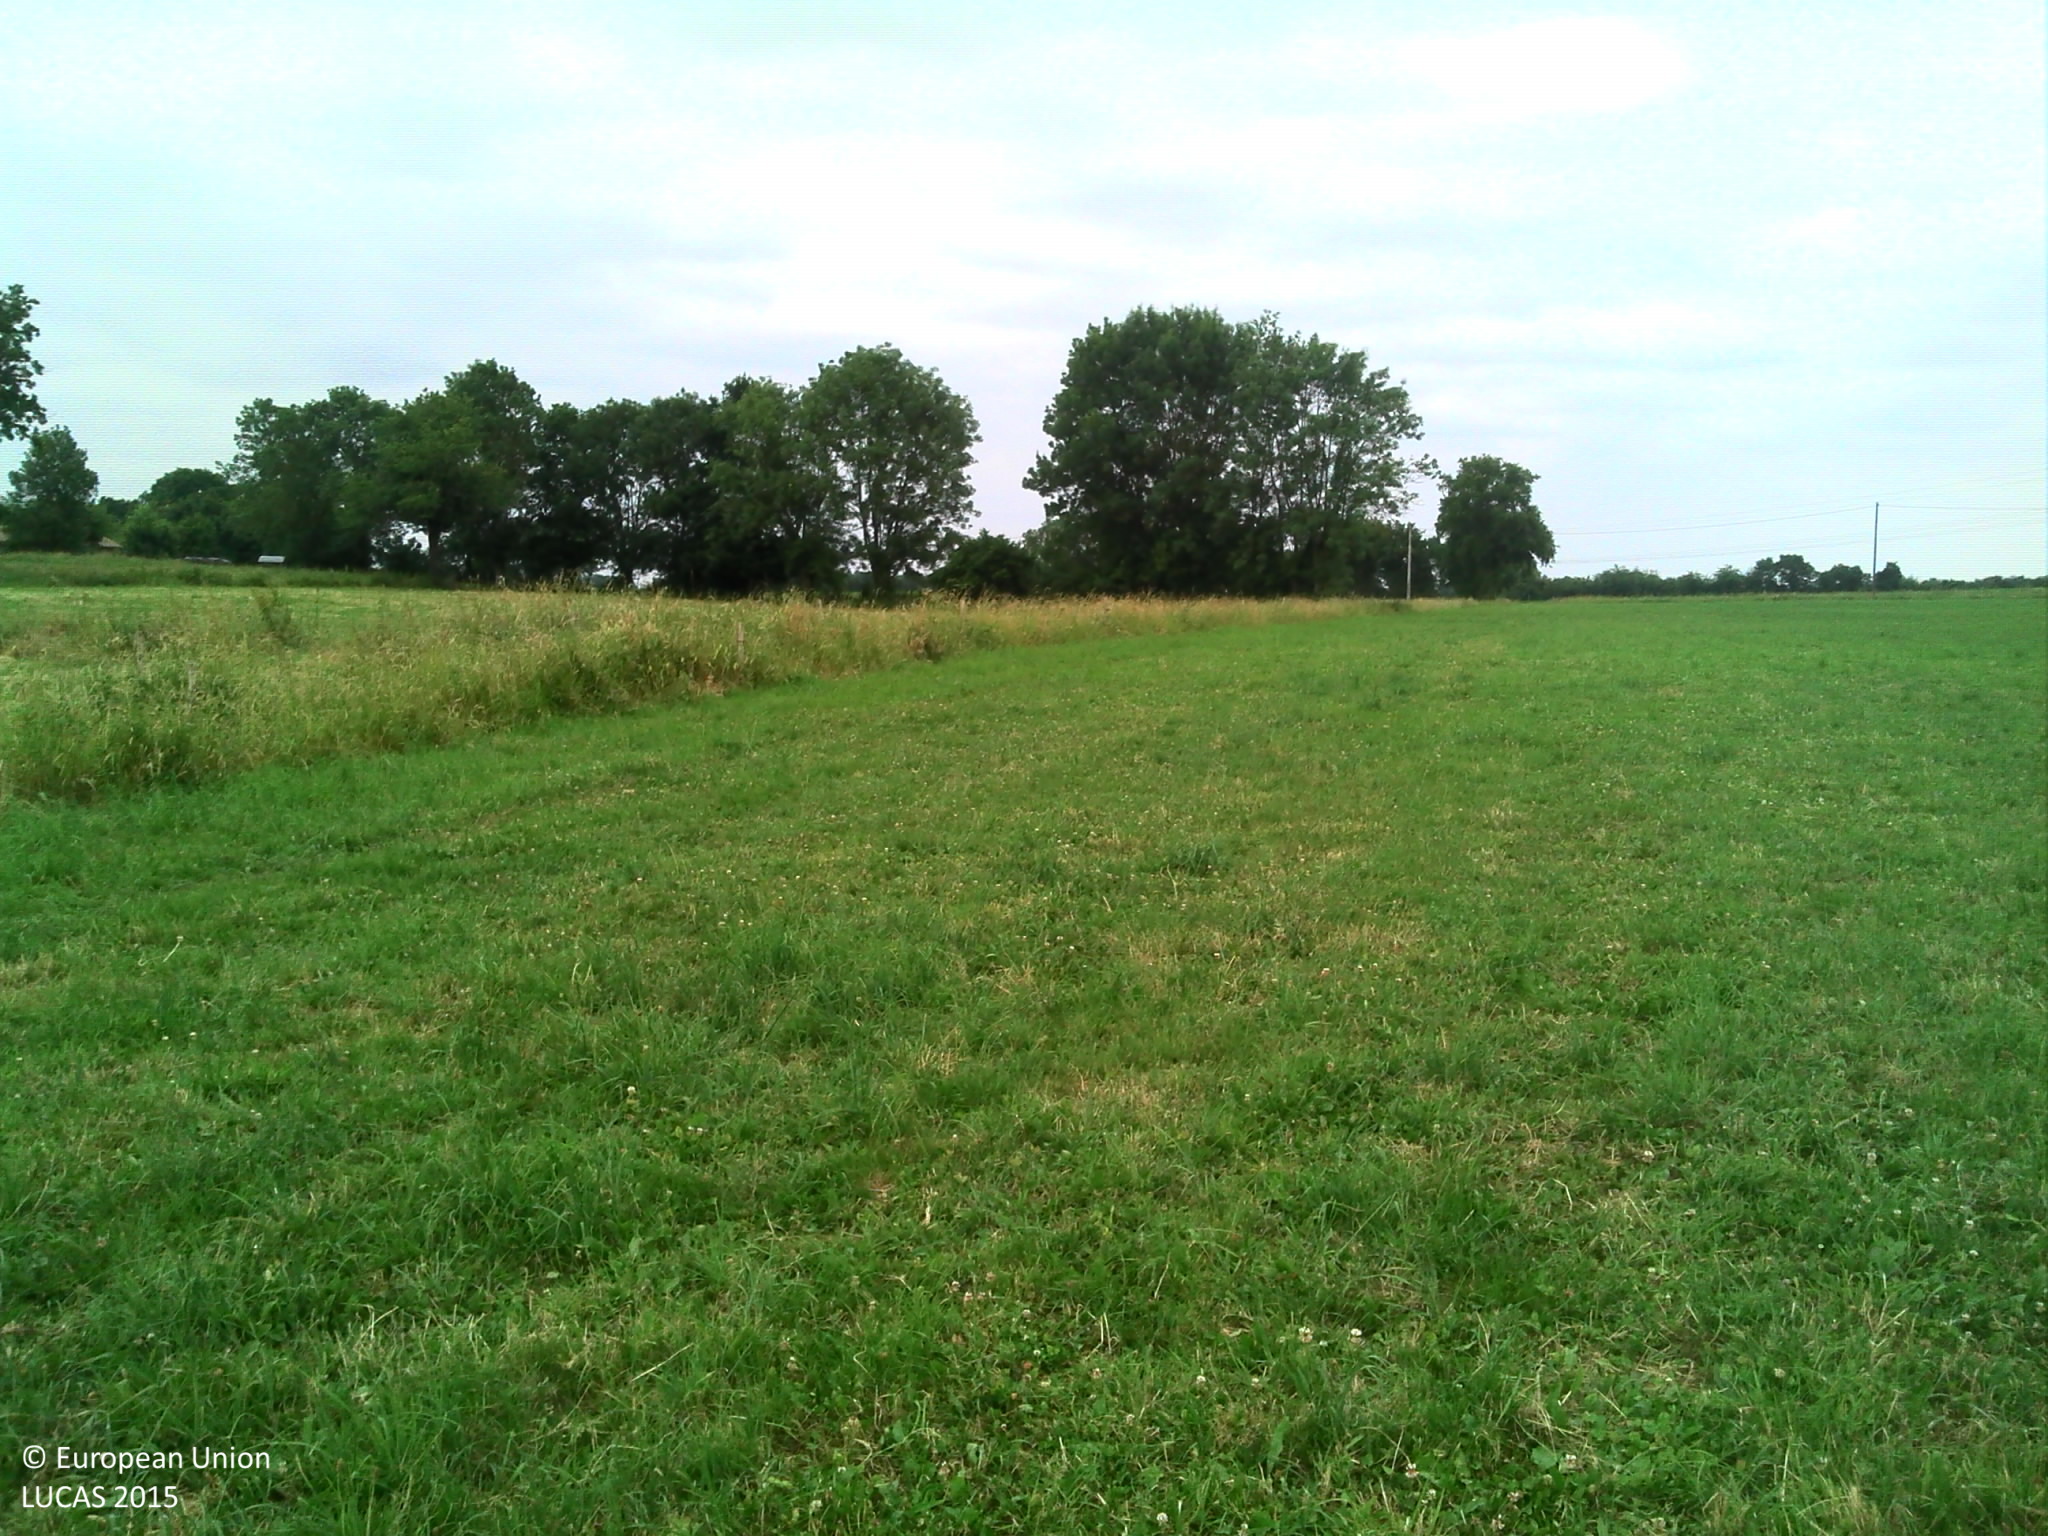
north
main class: Grassland
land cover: Grassland without tree/shrub cover
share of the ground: > 75 %
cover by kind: herbaceous plants 100 %
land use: Agriculture (excluding fallow land and kitchen gardens)
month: June
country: FR
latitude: 46.0837
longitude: 4.8689
